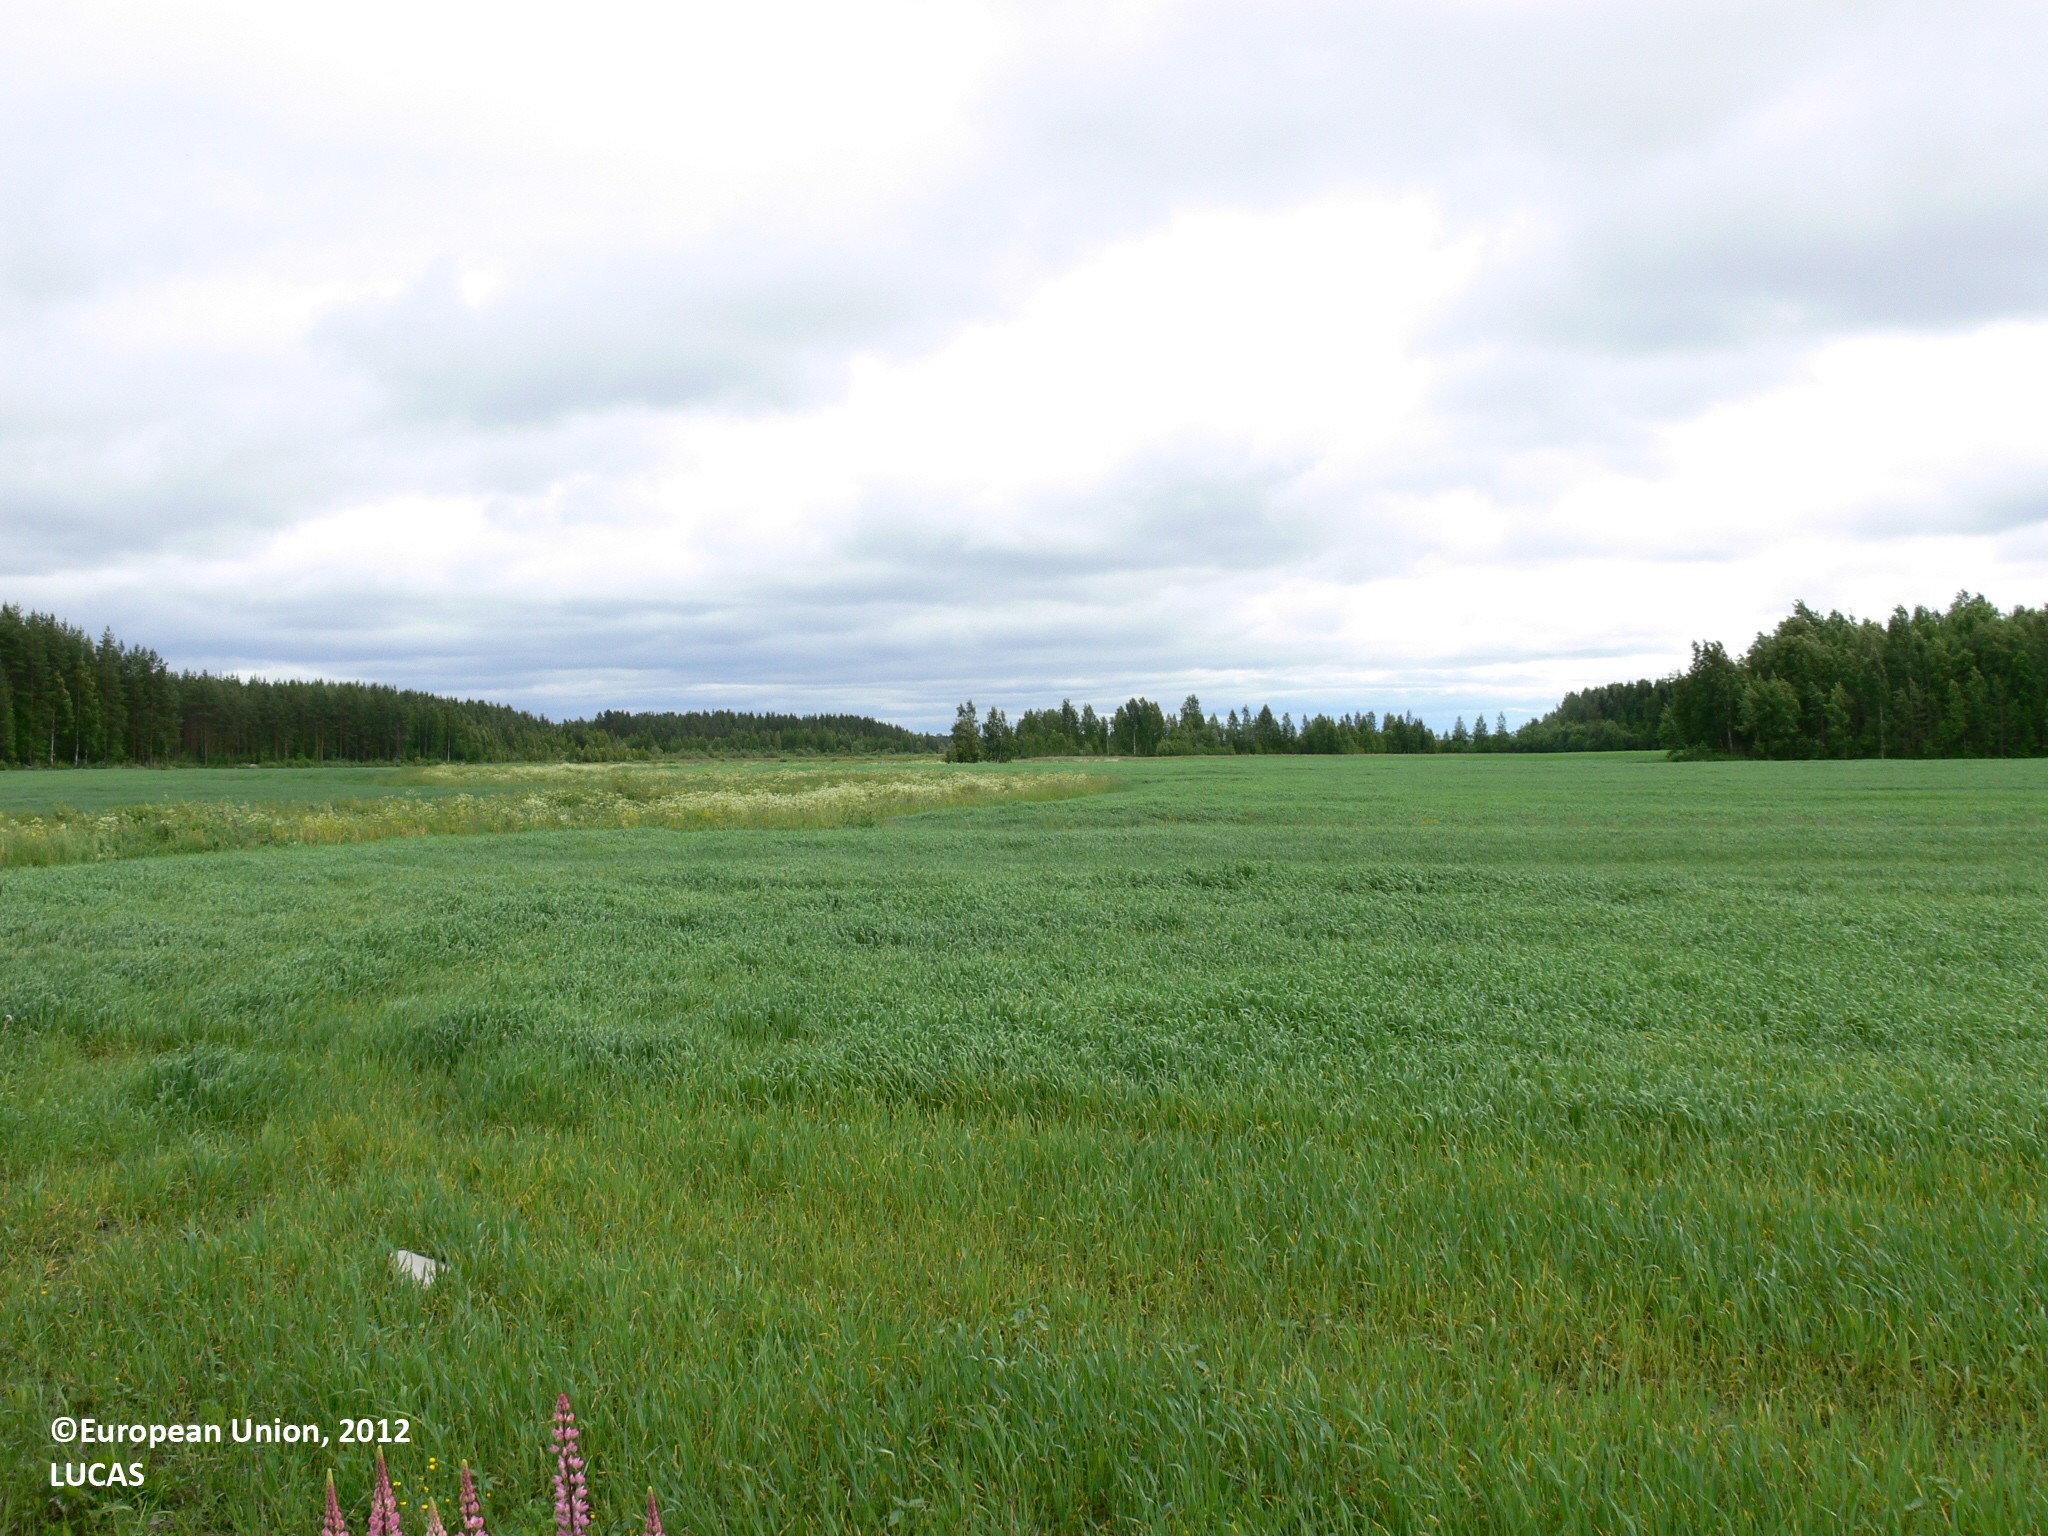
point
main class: Cropland
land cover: Barley
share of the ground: > 75 %
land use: Agriculture (excluding fallow land and kitchen gardens)
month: June
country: FI
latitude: 62.8216
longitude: 29.2819
